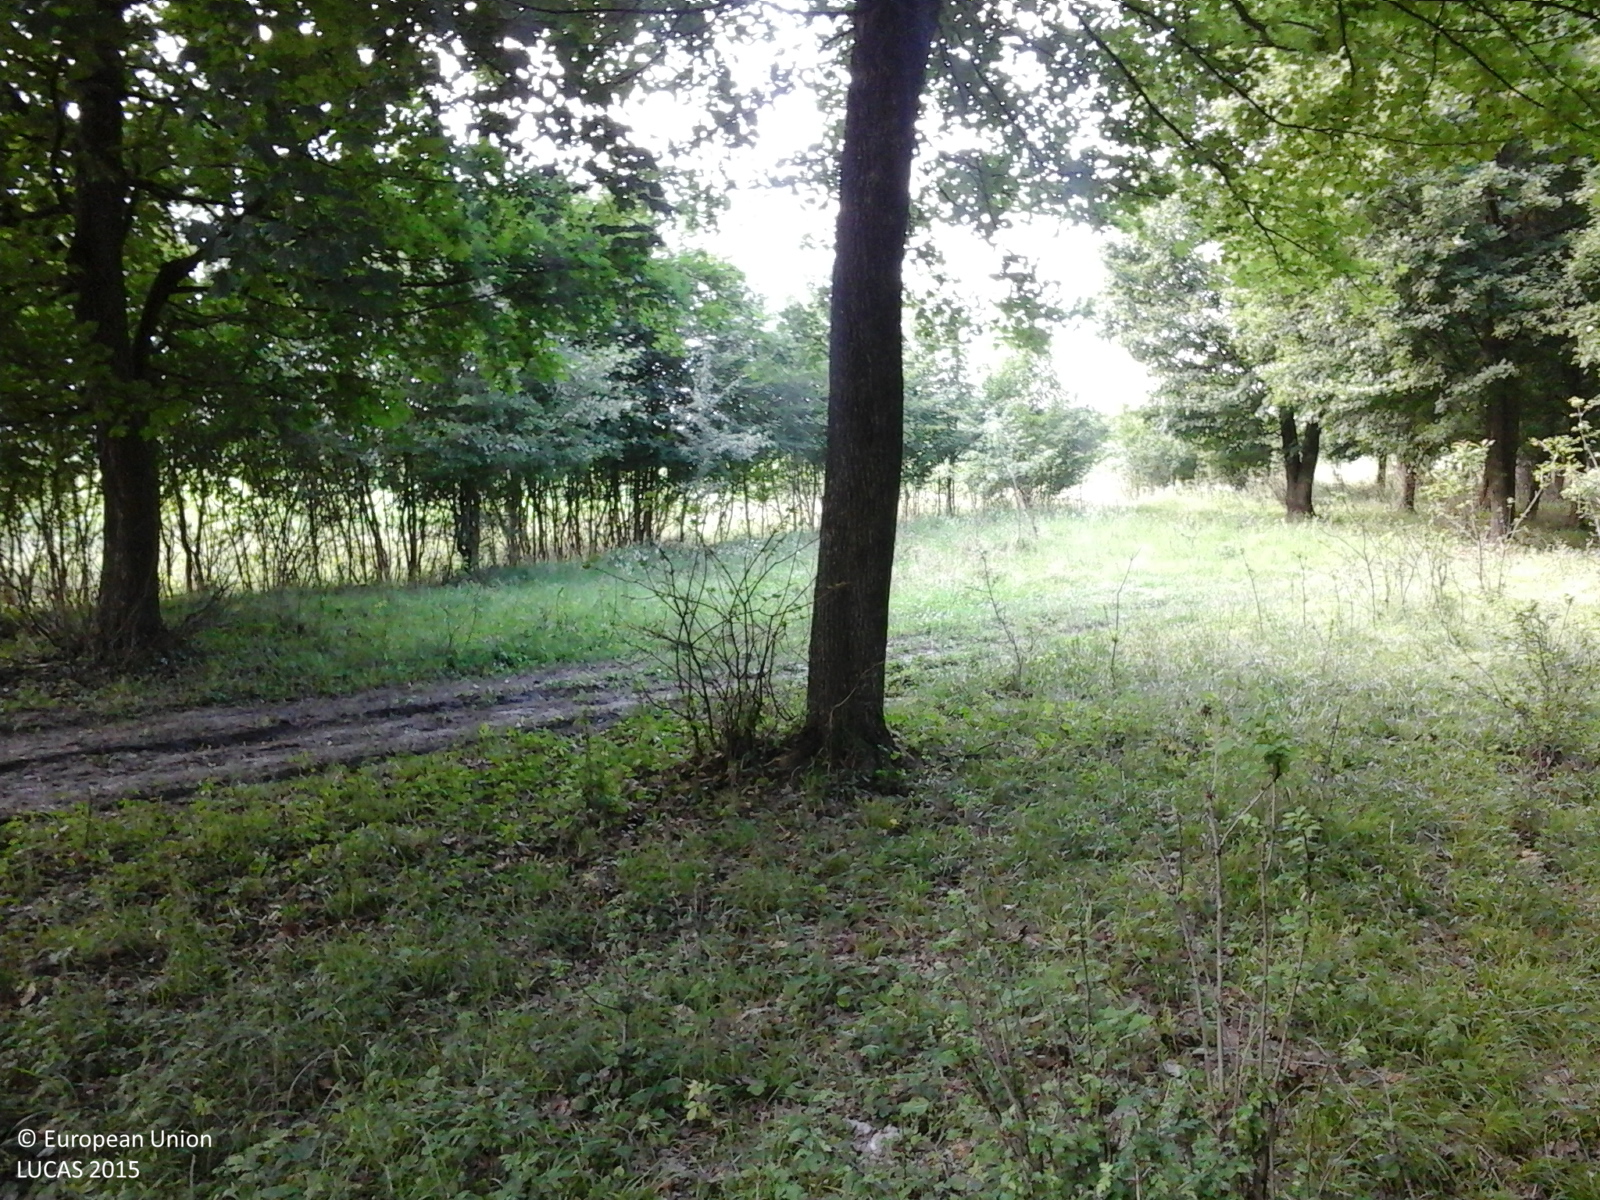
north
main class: Woodland
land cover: Broadleaved woodland
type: mesophytic deciduous forest
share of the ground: > 75 %
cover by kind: broadleaved forest trees 80 %, herbaceous plants 20 %
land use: Forestry
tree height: > 5 m
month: July
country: RO
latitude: 44.1835
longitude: 24.8998
